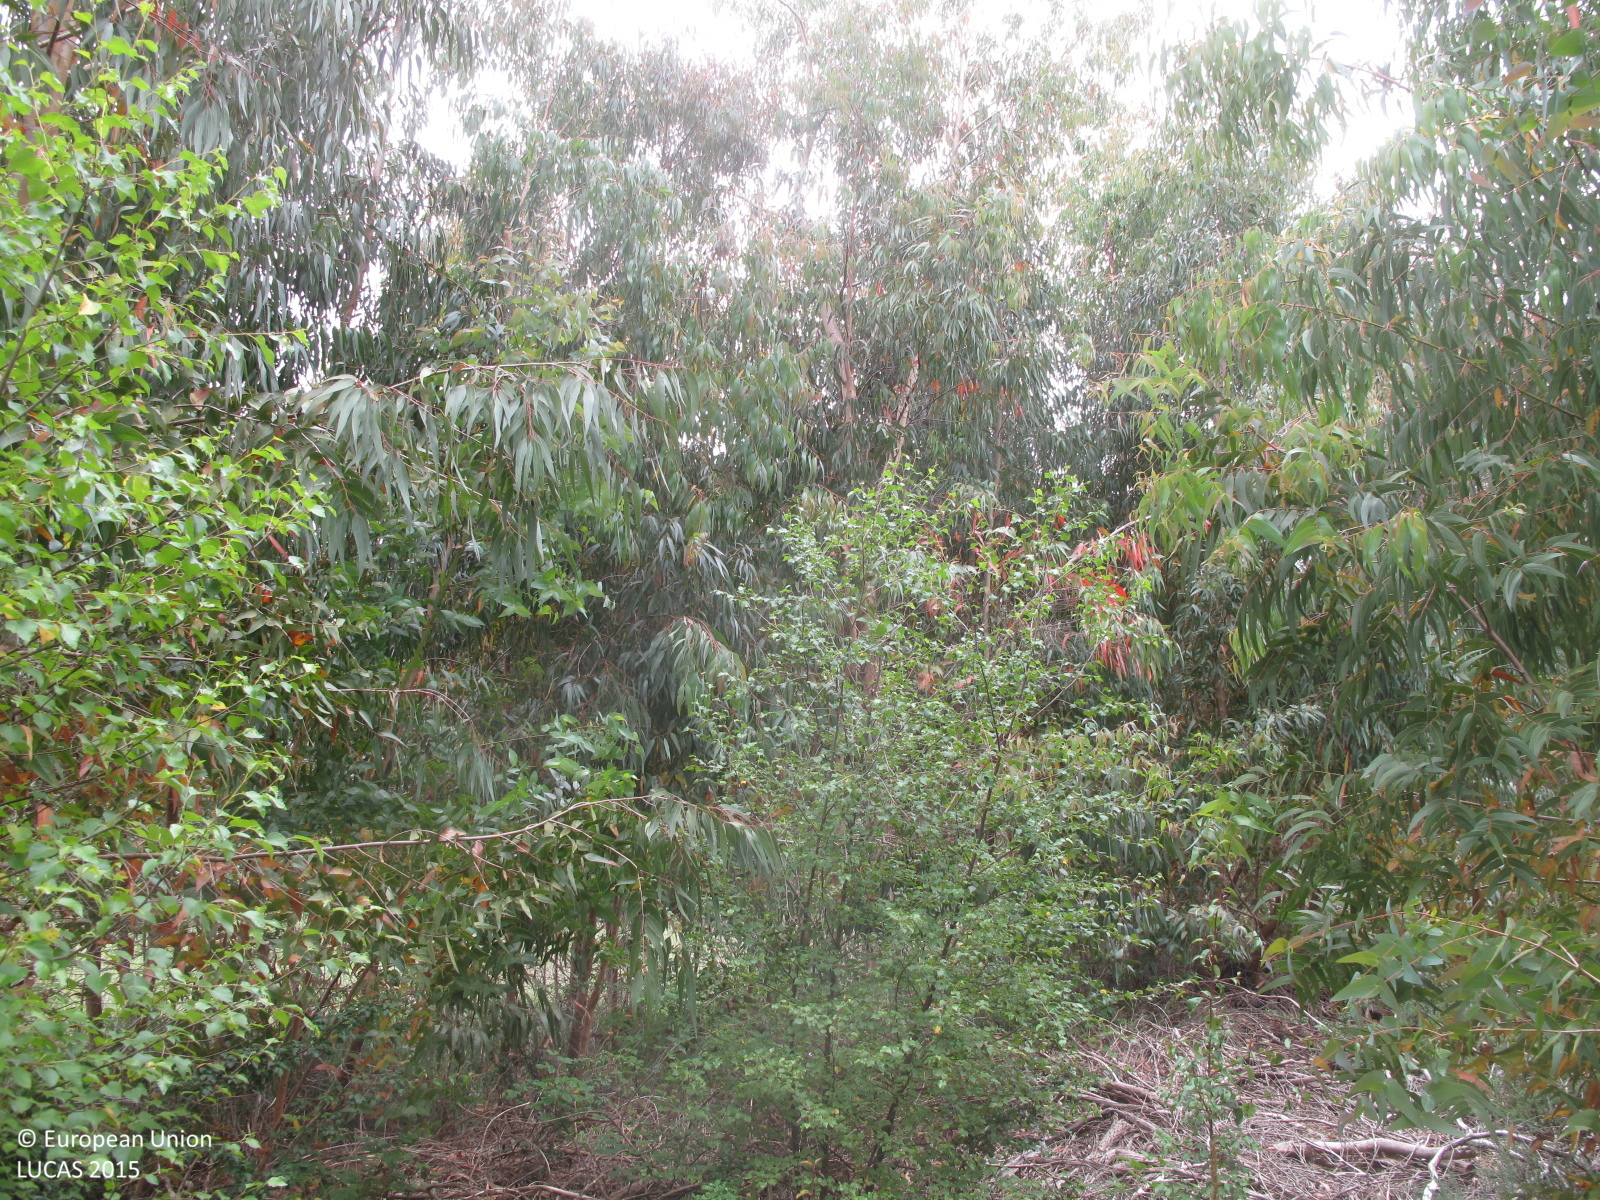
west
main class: Woodland
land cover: Broadleaved woodland
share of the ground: 50 - 75 %
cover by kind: broadleaved forest trees 70 %, shrubs 10 %, herbaceous plants 10 %, unconsolidated bare surface 10 %
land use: Forestry
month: June
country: ES
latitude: 43.1643
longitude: -8.1142
